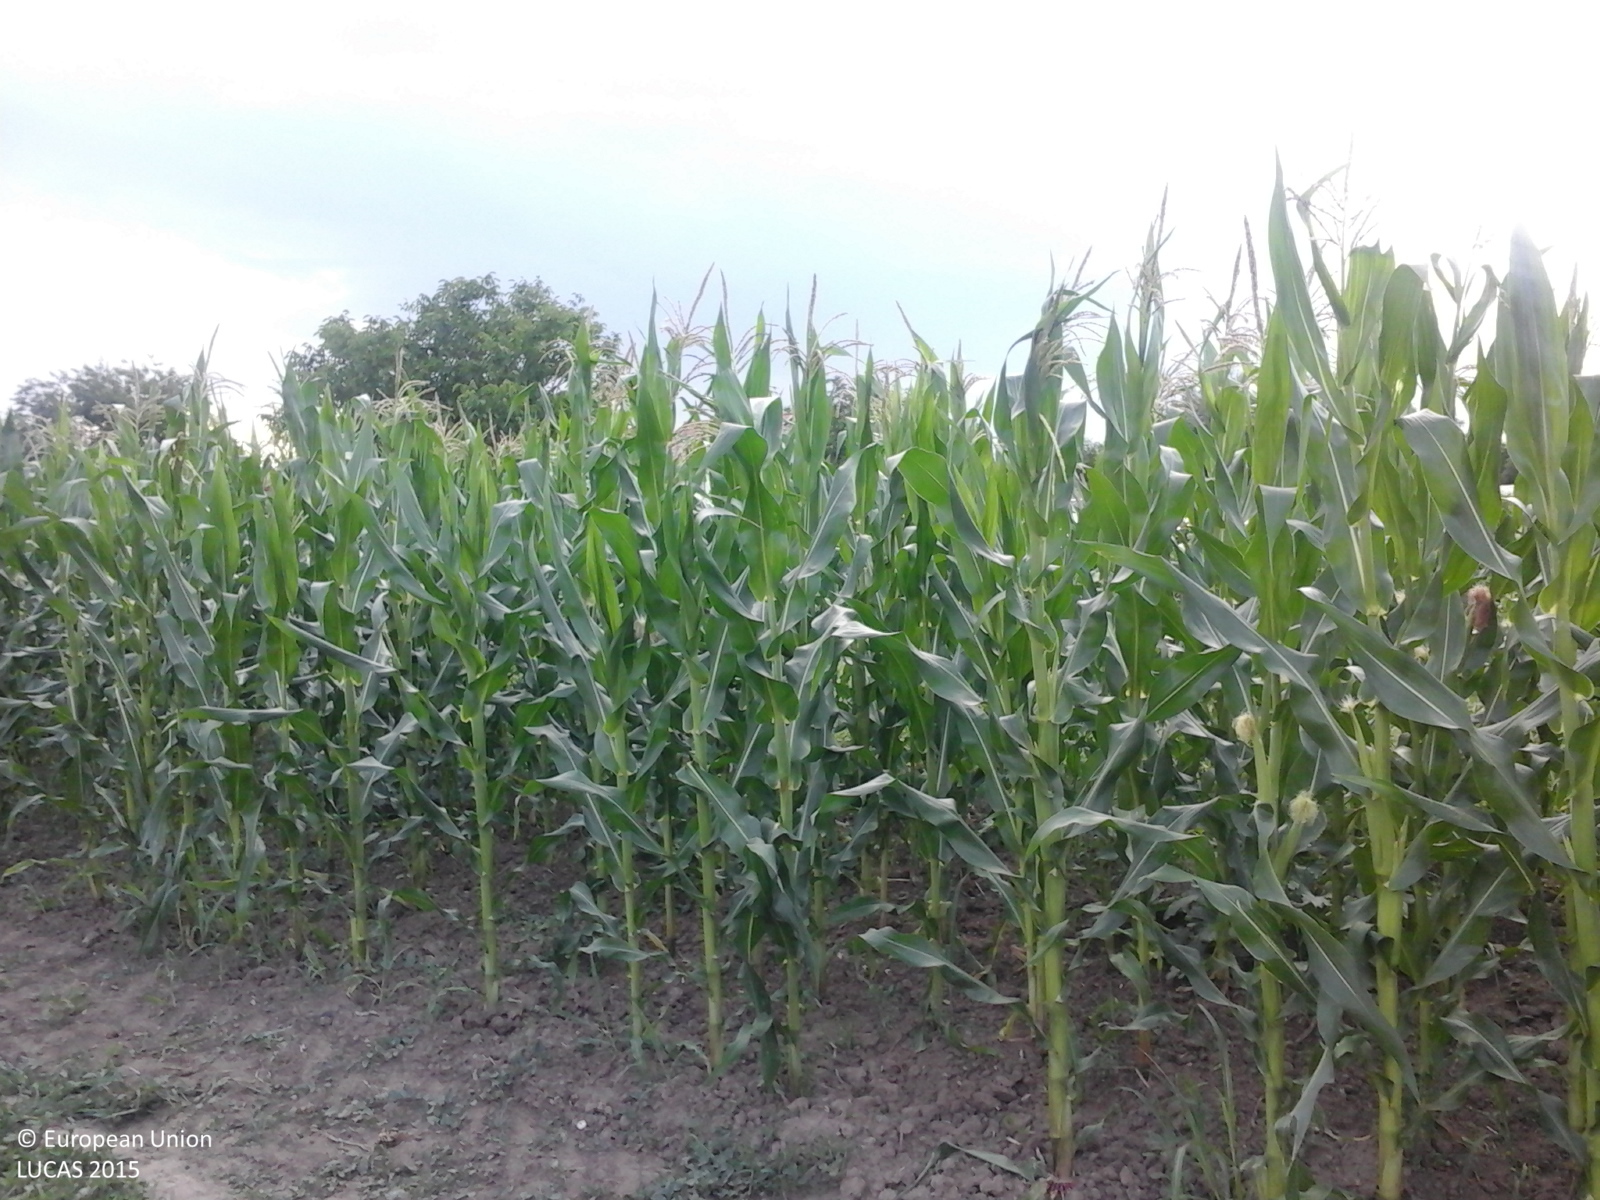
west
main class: Cropland
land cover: Maize
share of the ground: > 75 %
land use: Agriculture (excluding fallow land and kitchen gardens)
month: June
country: RO
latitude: 44.3175
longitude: 26.1923
